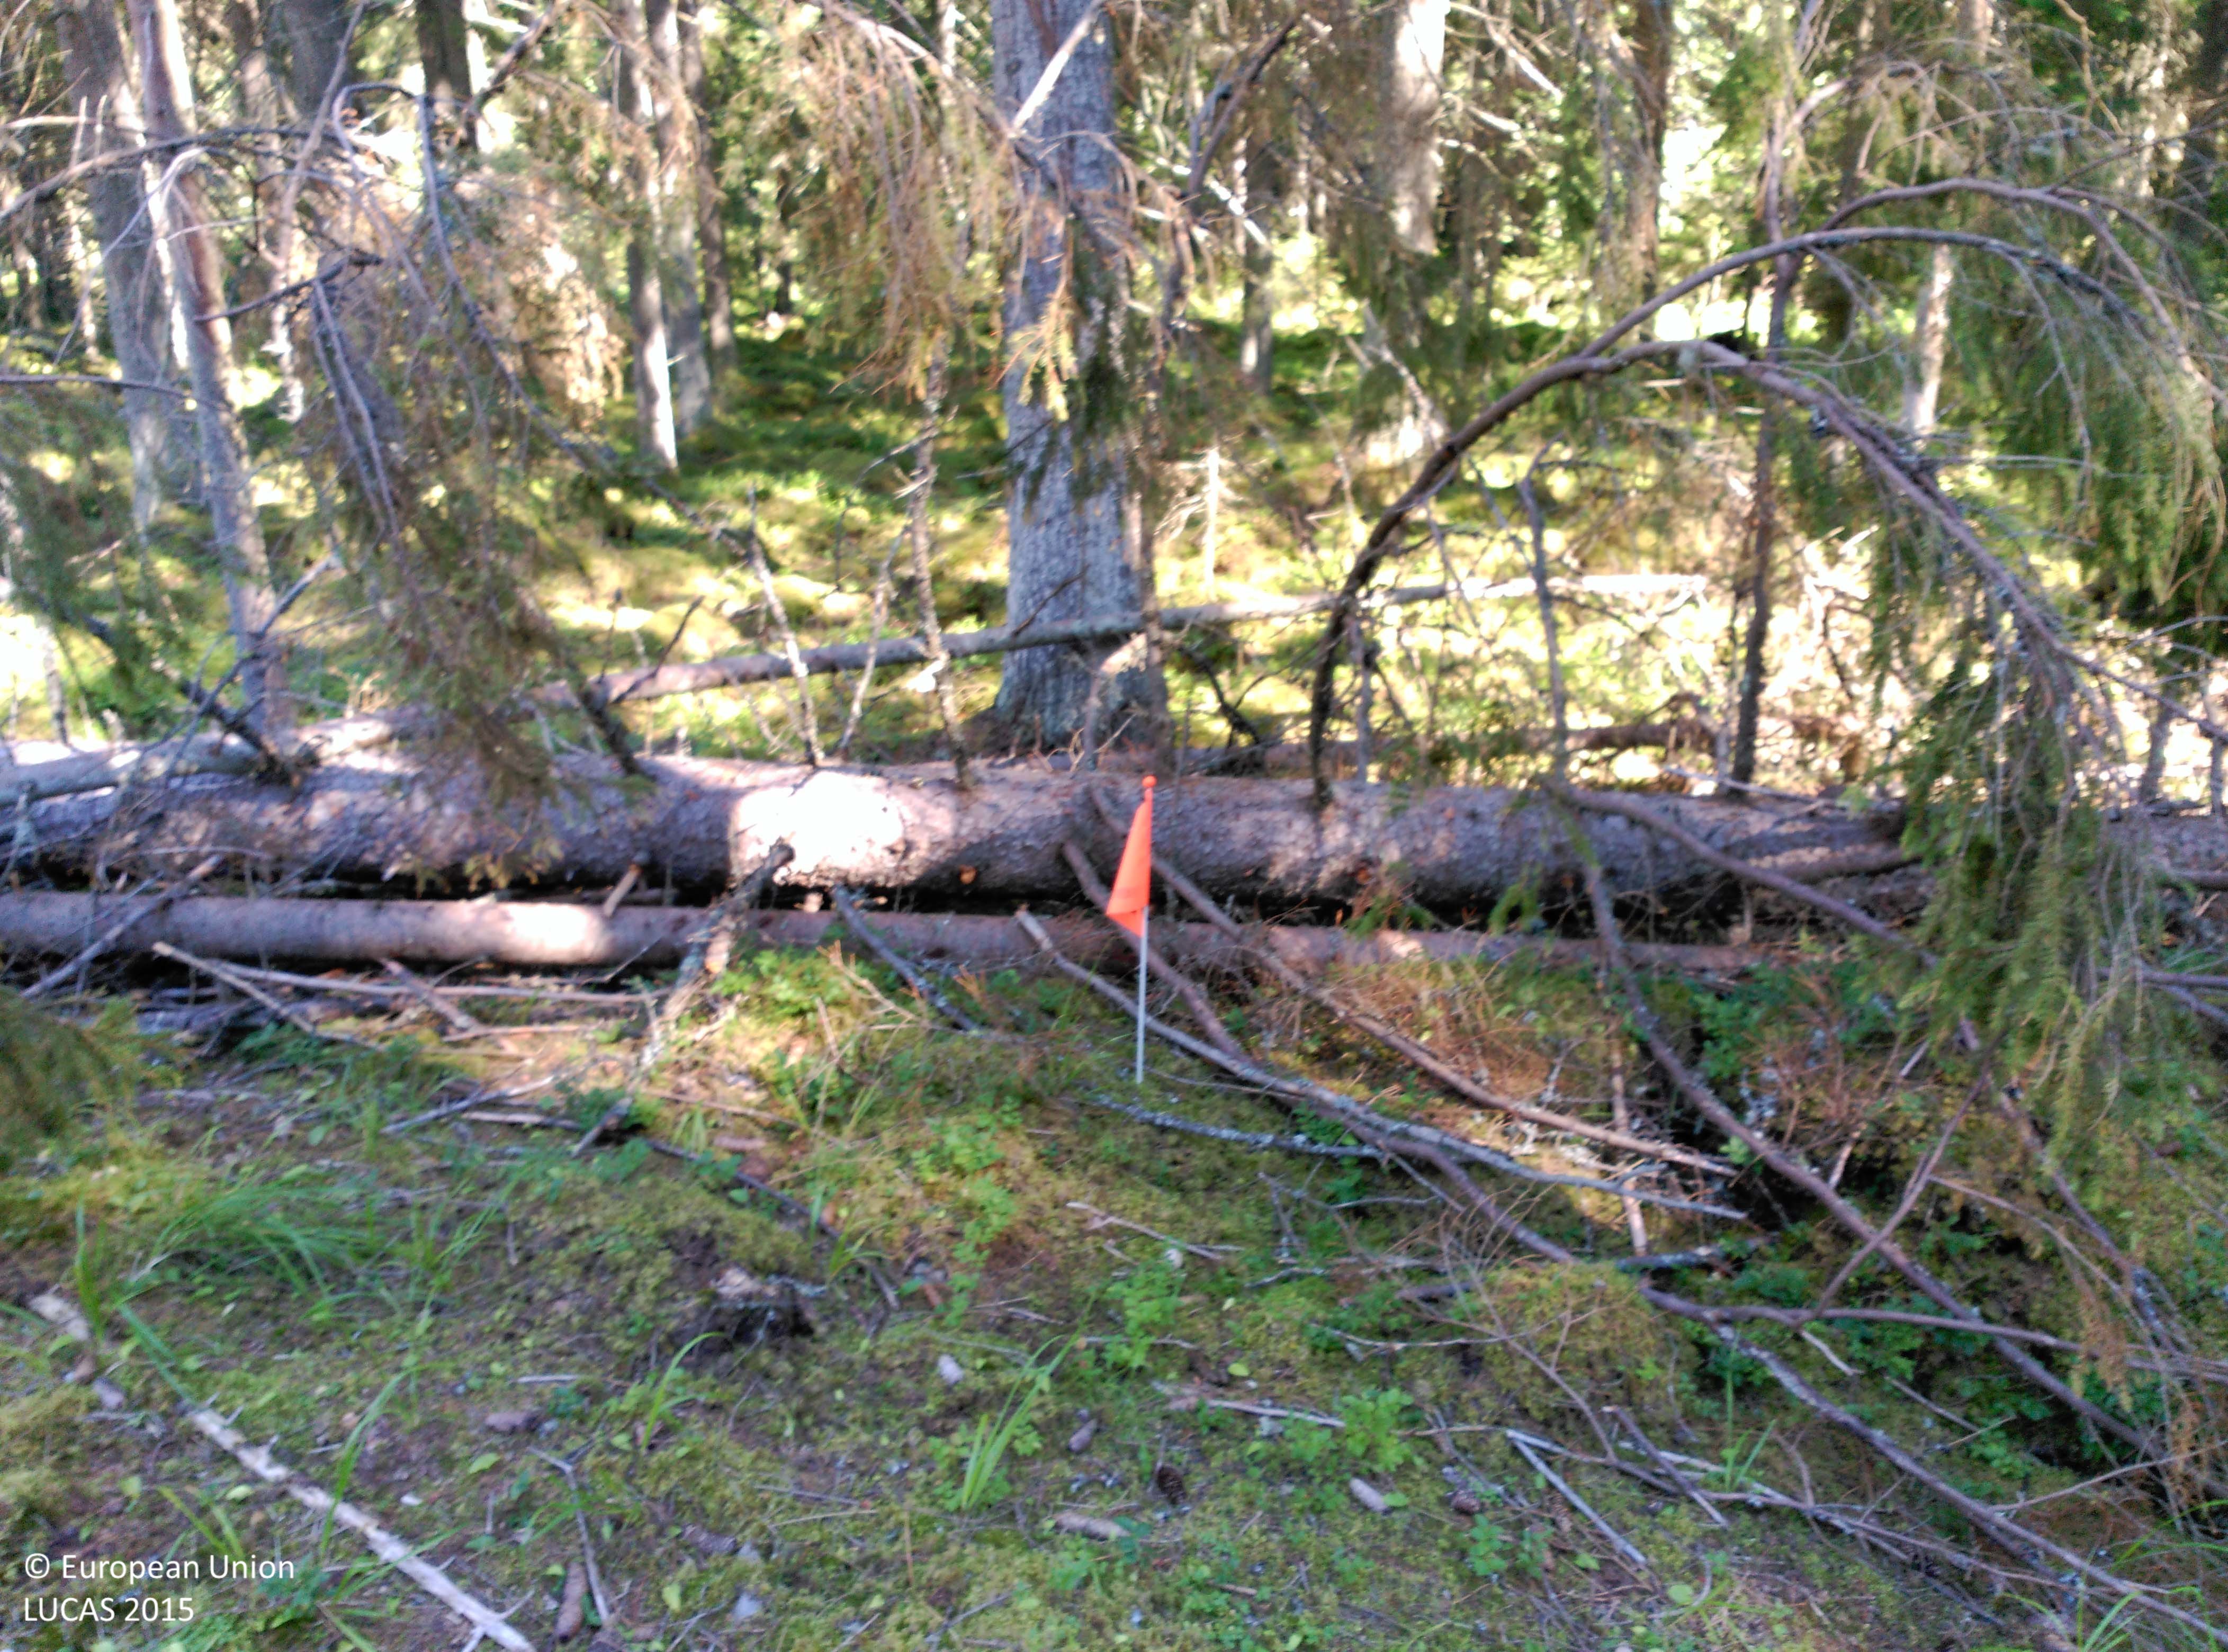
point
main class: Woodland
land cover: Spruce dominated coniferous woodland
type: hemiboreal forest and nemoral coniferous forest and mixed broadleaved-coniferous forest
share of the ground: 50 - 75 %
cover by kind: coniferous forest trees 65 %, lichens and mosses 25 %, shrubs 10 %
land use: Forestry
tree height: > 5 m
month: August
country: FI
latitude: 61.0506
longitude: 22.8697
